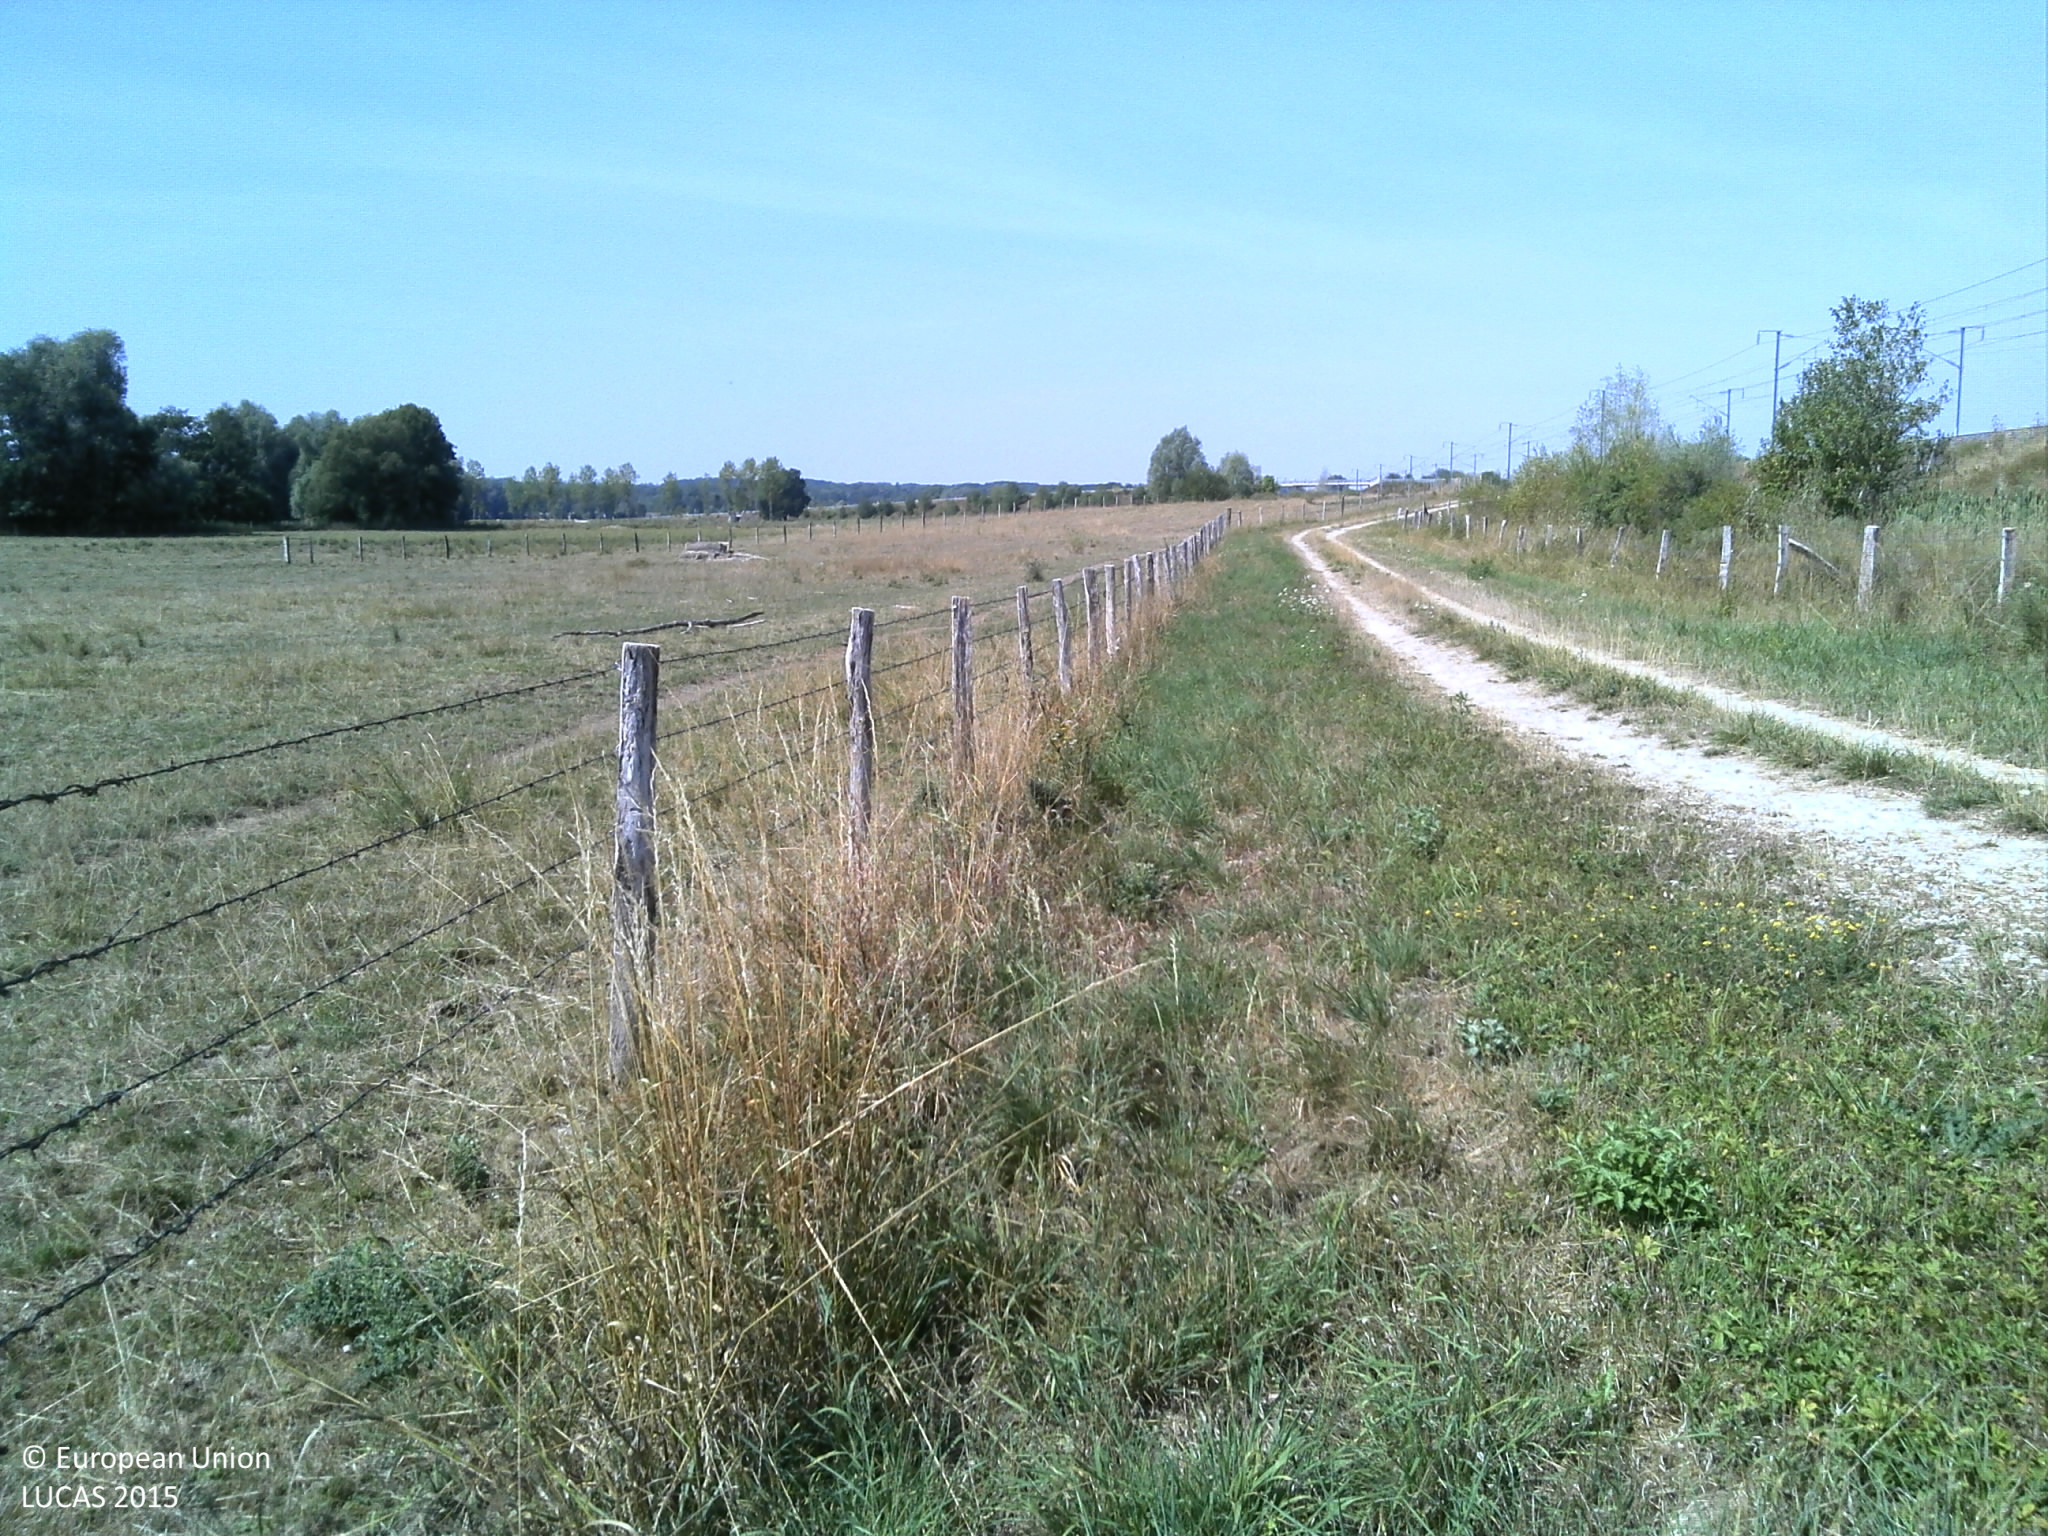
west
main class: Grassland
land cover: Grassland without tree/shrub cover
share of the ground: > 75 %
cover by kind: herbaceous plants 100 %
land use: Agriculture (excluding fallow land and kitchen gardens)
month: August
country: FR
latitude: 49.0106
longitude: 4.9803
